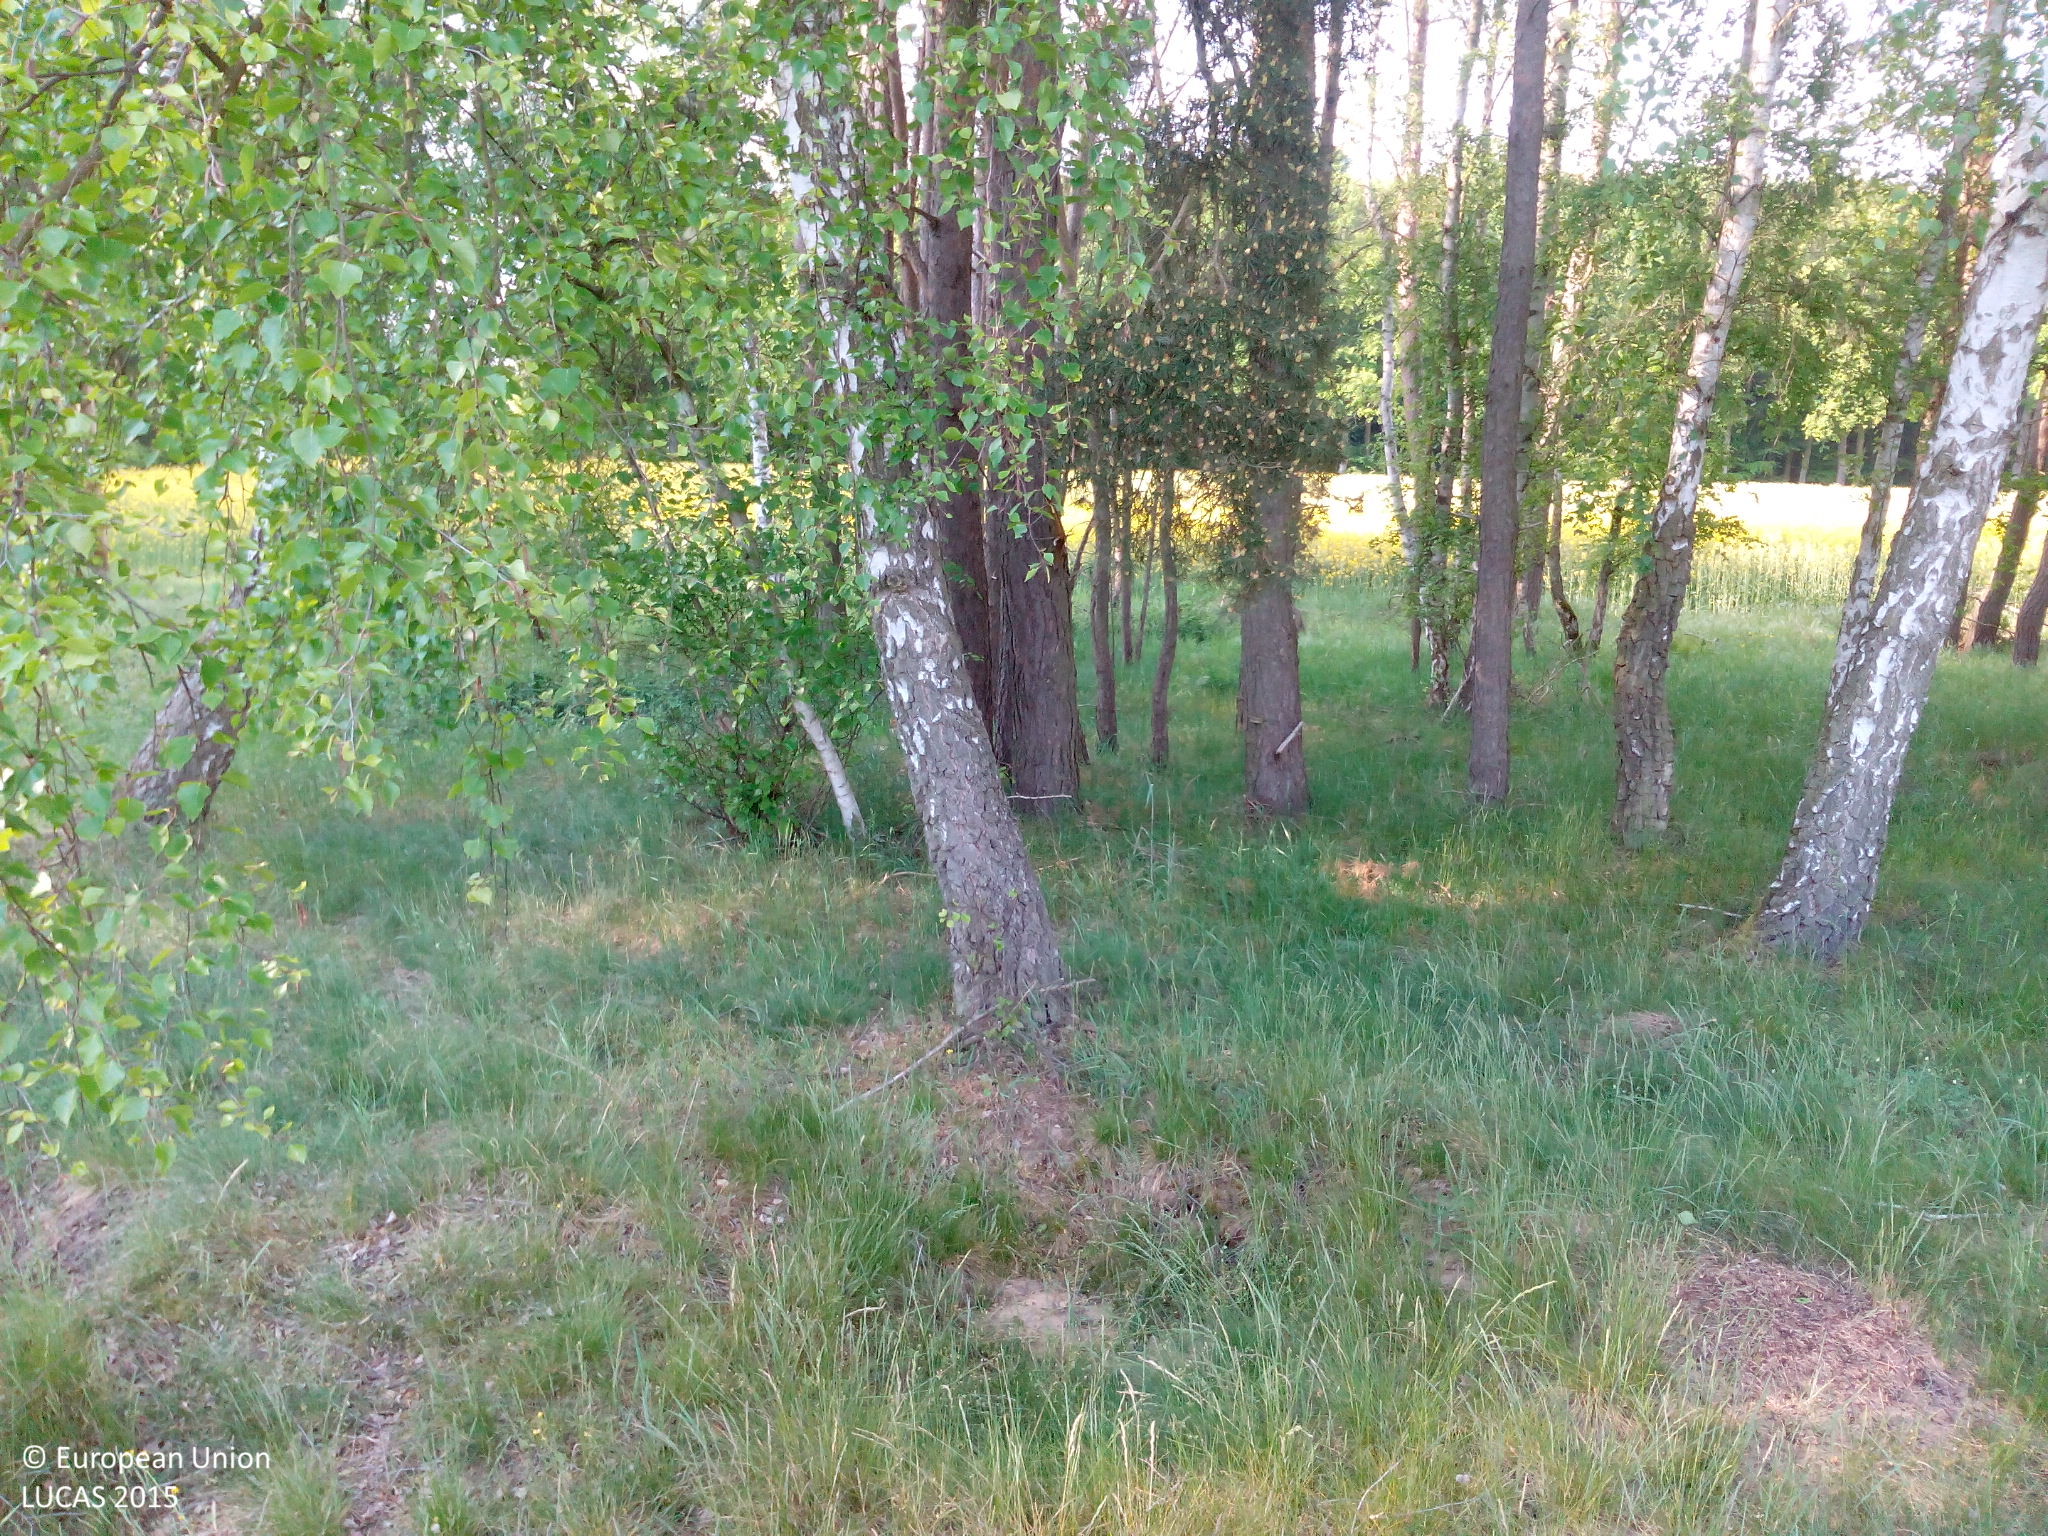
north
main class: Grassland
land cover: Grassland without tree/shrub cover
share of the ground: > 75 %
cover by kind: herbaceous plants 90 %, unconsolidated bare surface 10 %
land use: Agriculture (excluding fallow land and kitchen gardens)
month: May
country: DE
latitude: 52.7315
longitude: 11.1399
